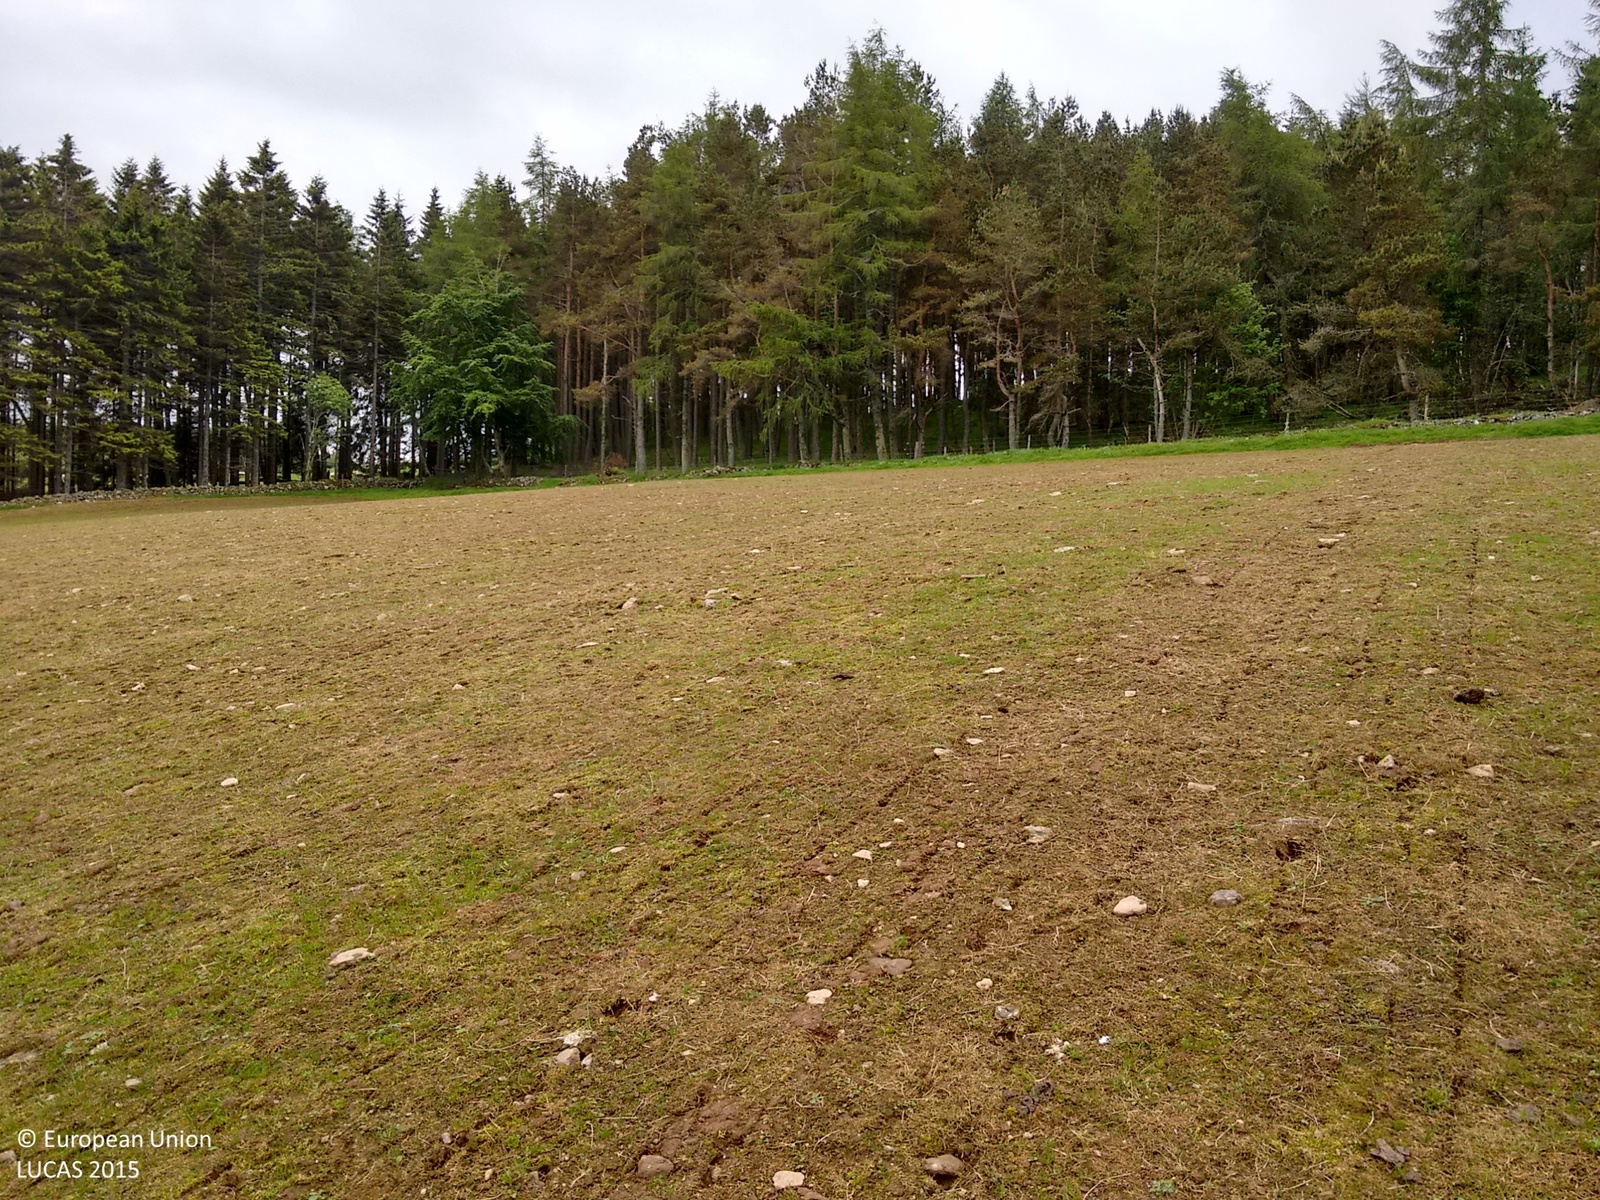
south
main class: Grassland
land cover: Grassland without tree/shrub cover
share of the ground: 25 - 50 %
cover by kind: herbaceous plants 60 %, unconsolidated bare surface 40 %
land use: Agriculture (excluding fallow land and kitchen gardens)
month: June
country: GB
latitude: 57.1831
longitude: -2.8150
